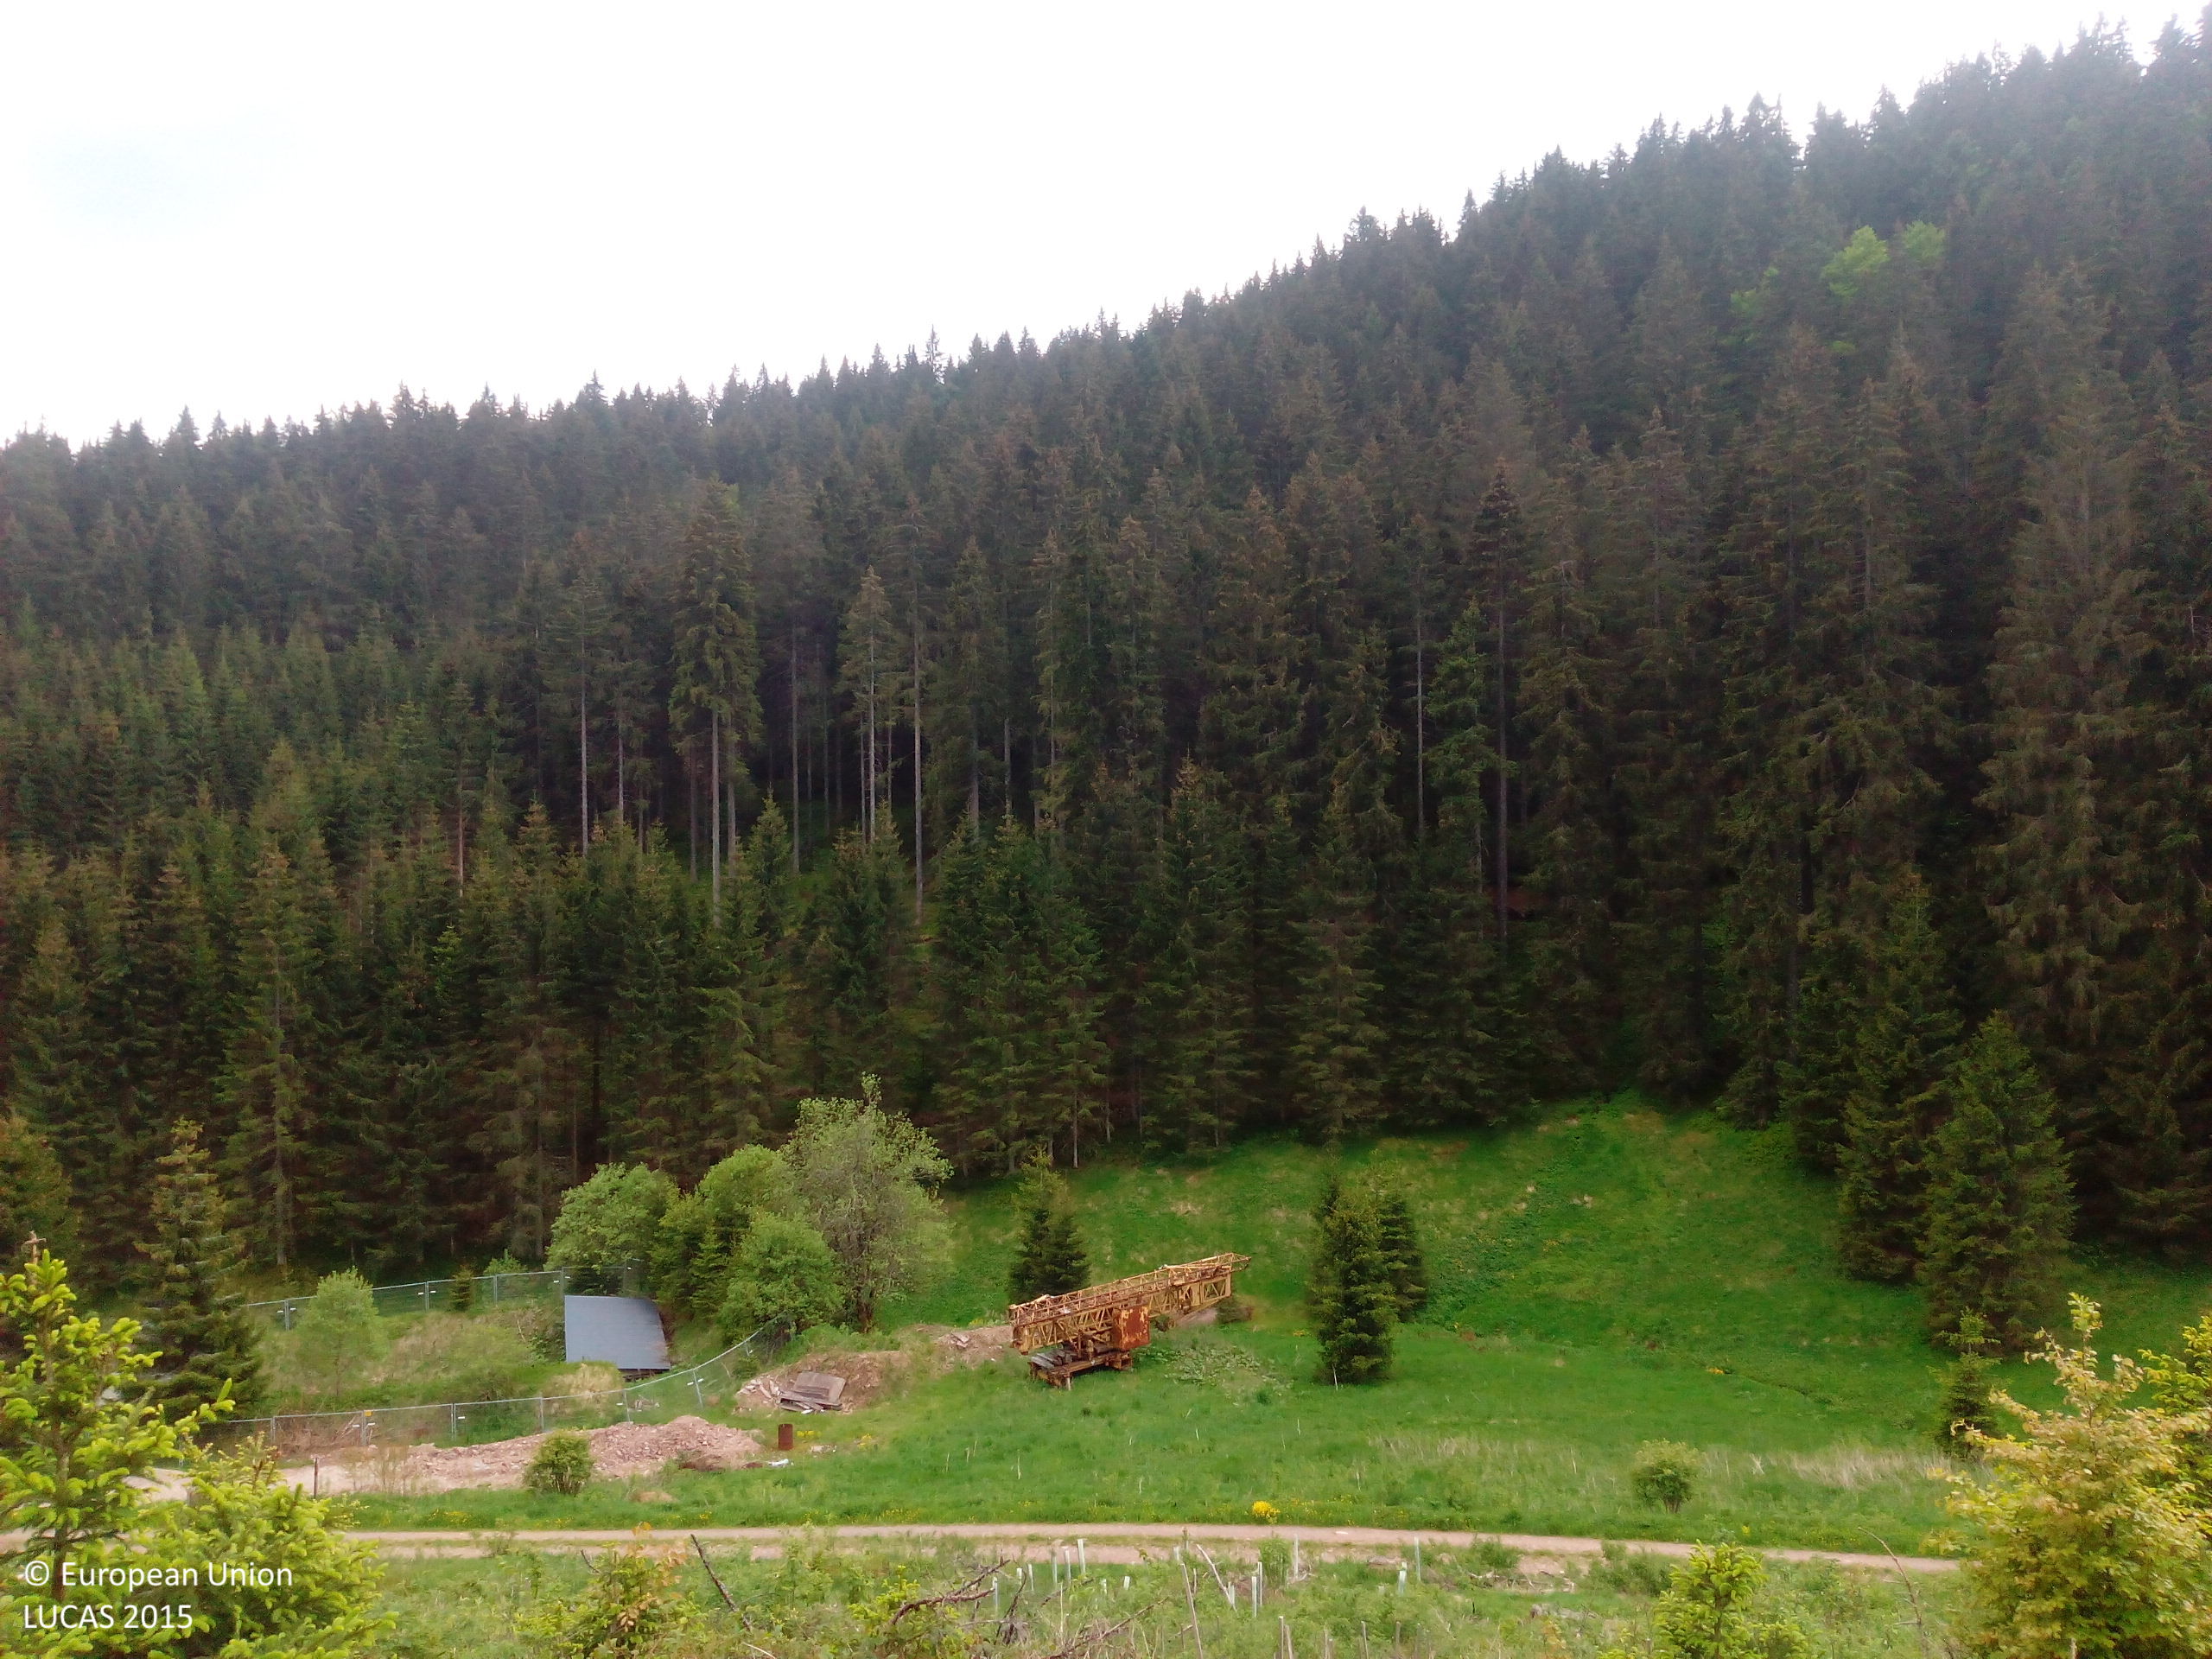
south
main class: Woodland
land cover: Spruce dominated coniferous woodland
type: hemiboreal forest and nemoral coniferous forest and mixed broadleaved-coniferous forest
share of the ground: 25 - 50 %
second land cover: Shrubland without tree cover
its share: 50 - 75 %
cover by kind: coniferous forest trees 40 %, shrubs 40 %, herbaceous plants 20 %
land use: Forestry
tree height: < 5 m
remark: Clear cut
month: May
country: DE
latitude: 48.0647
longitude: 8.1894
